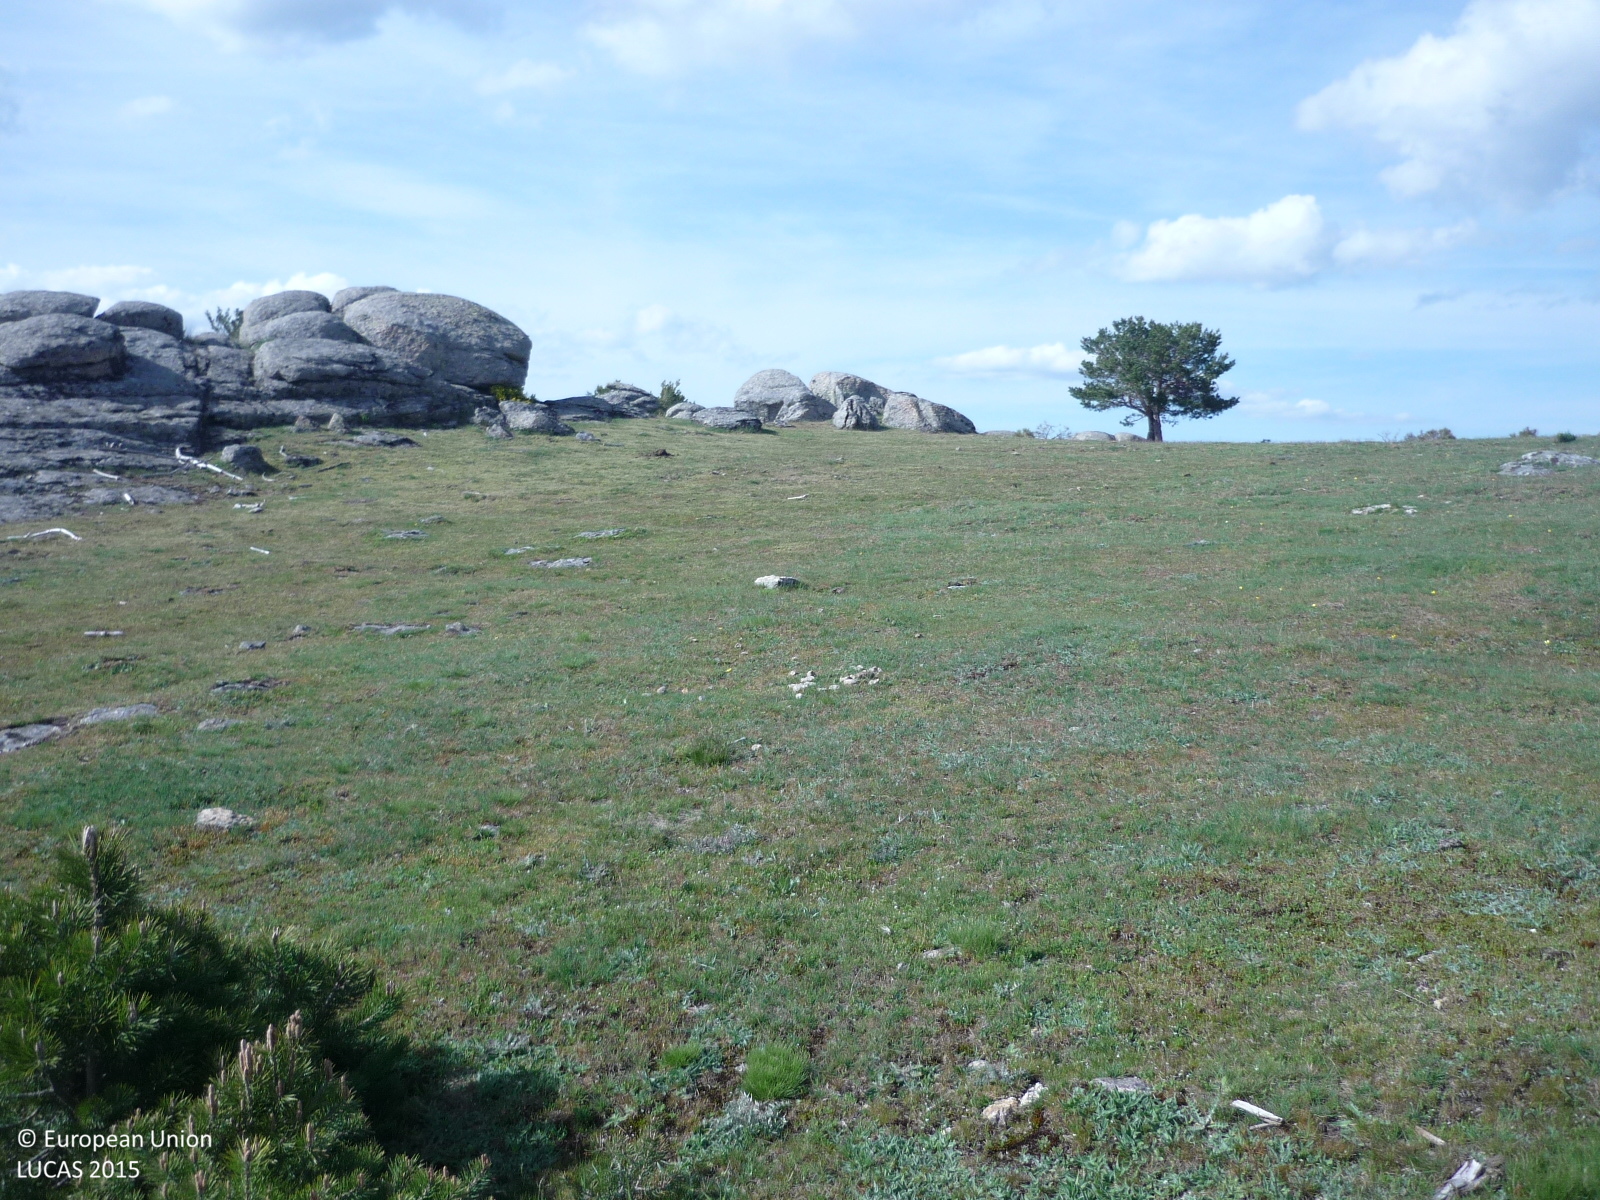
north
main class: Grassland
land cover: Grassland with sparse tree/shrub cover
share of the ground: > 75 %
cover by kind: herbaceous plants 85 %, shrubs 10 %, coniferous forest trees 5 %
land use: Agriculture (excluding fallow land and kitchen gardens)
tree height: < 5 m
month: May
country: ES
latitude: 40.8388
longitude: -3.8375
